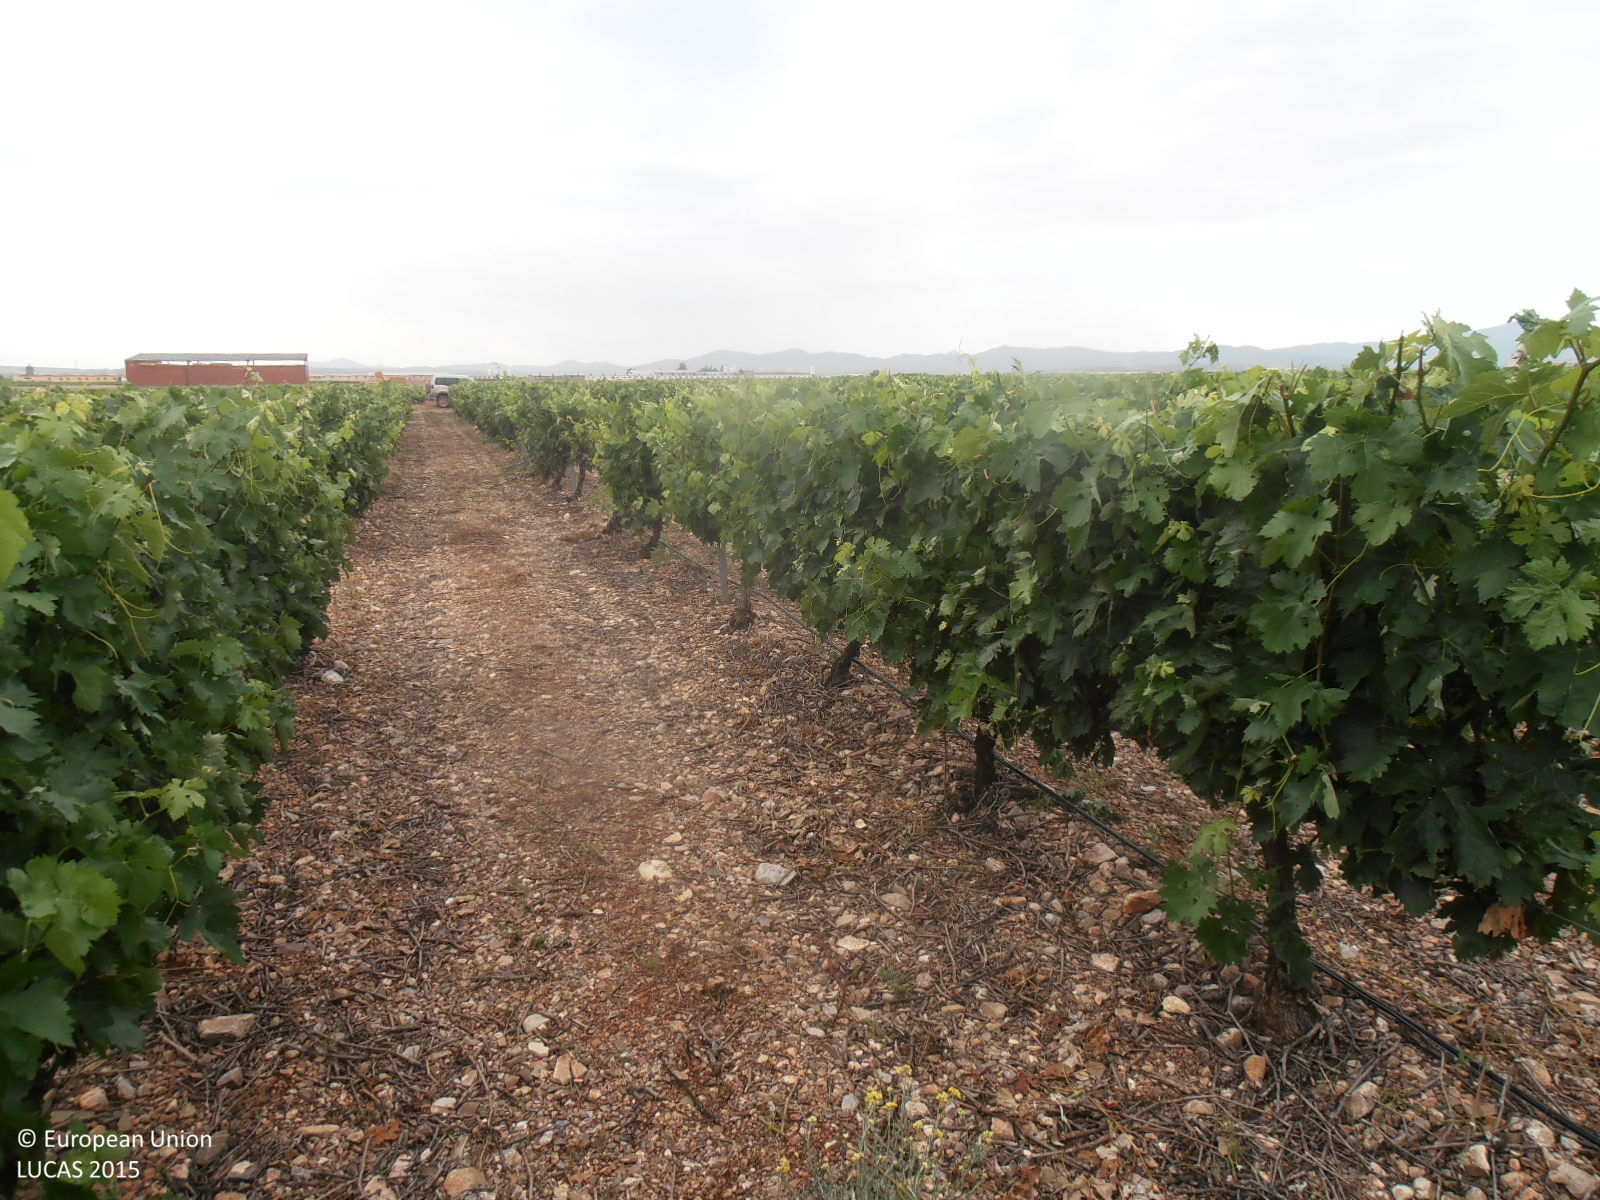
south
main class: Cropland
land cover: Vineyards
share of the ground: 10 - 25 %
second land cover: Other bare soil
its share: > 75 %
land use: Agriculture (excluding fallow land and kitchen gardens)
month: June
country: ES
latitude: 41.3569
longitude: -1.1977
